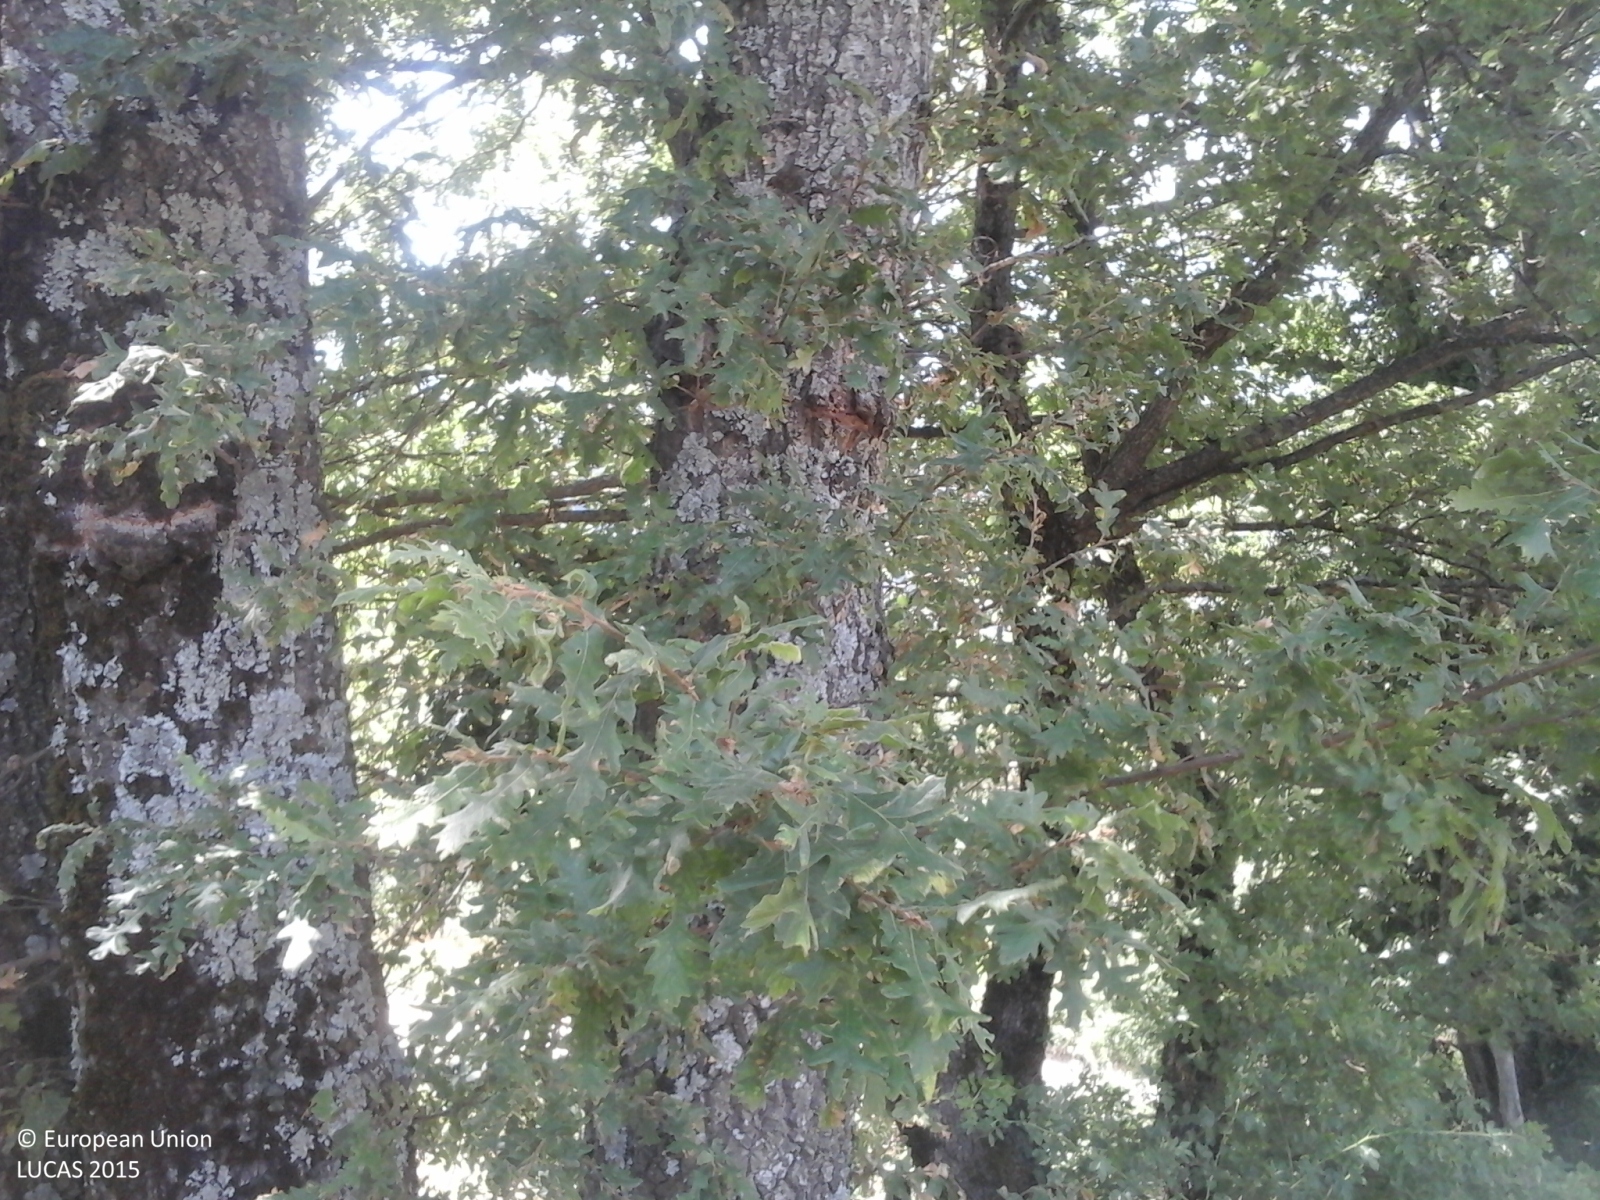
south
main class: Woodland
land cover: Broadleaved woodland
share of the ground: > 75 %
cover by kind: broadleaved forest trees 85 %
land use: Agriculture (excluding fallow land and kitchen gardens)
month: July
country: IT
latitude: 44.3501
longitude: 10.2879
